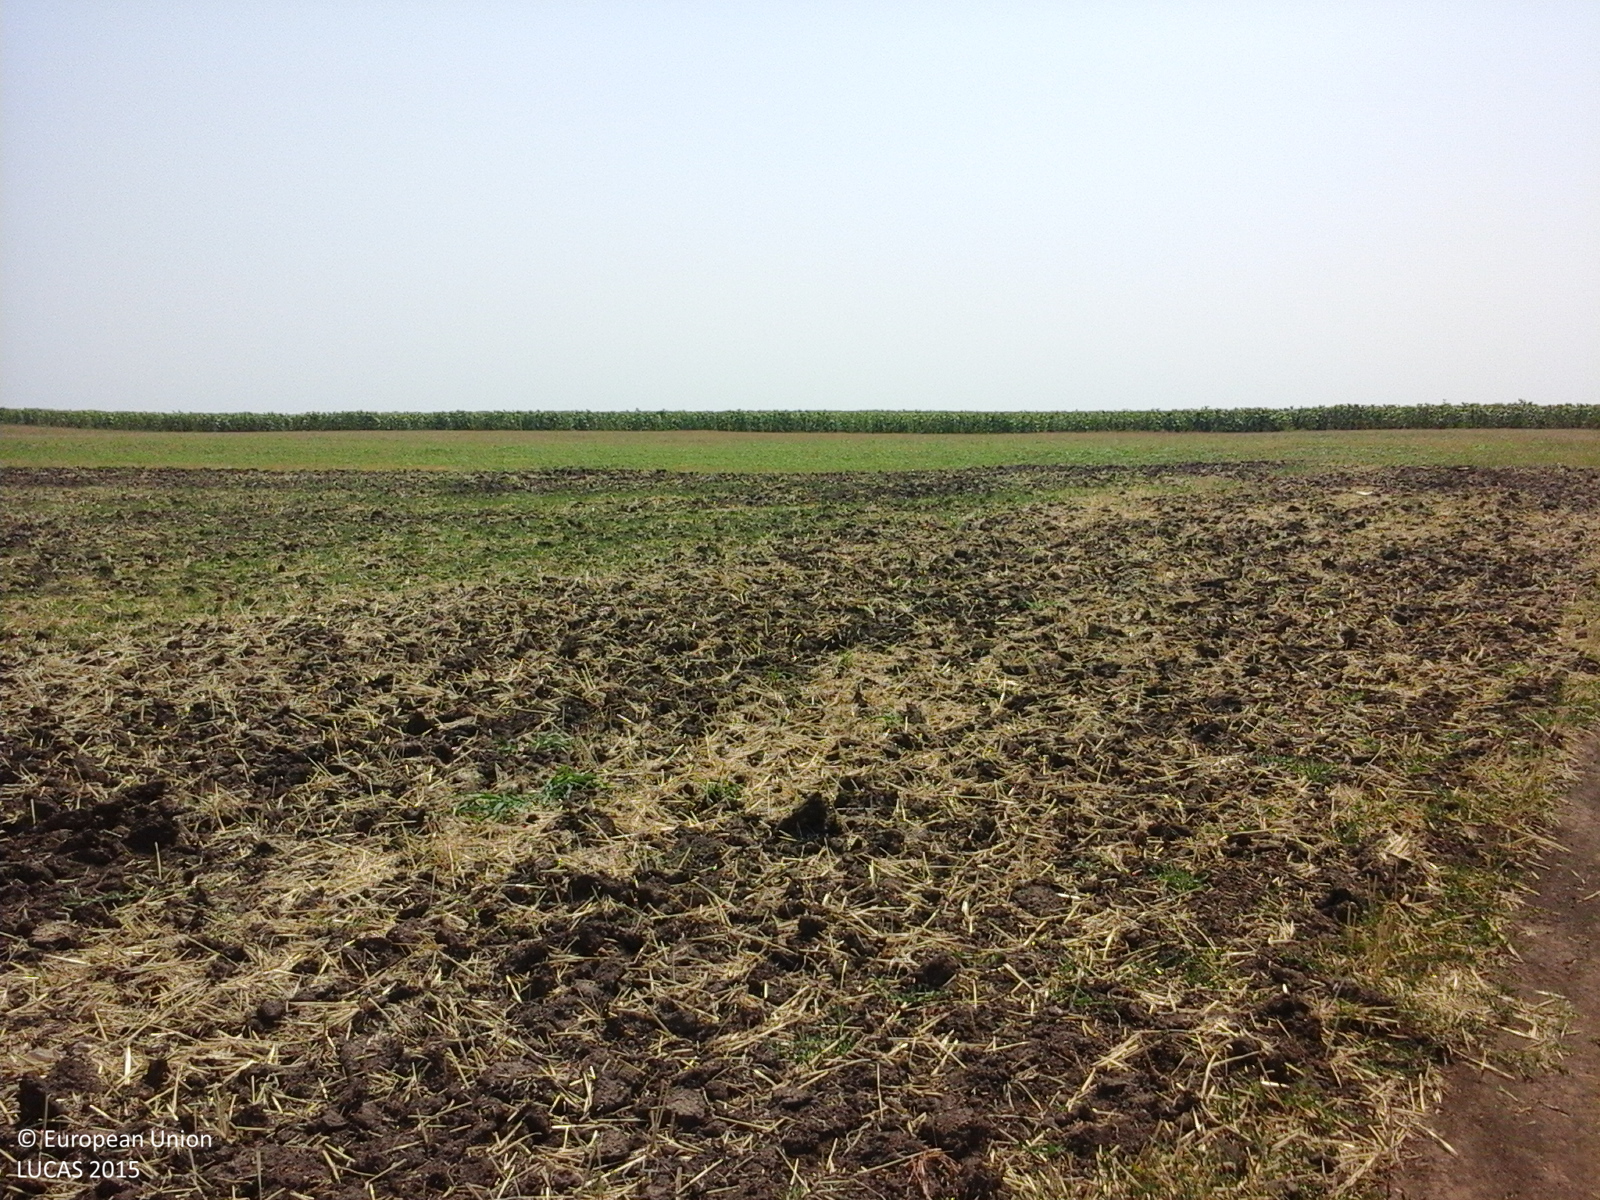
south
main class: Cropland
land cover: Maize
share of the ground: > 75 %
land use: Agriculture (excluding fallow land and kitchen gardens)
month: July
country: RO
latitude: 45.6782
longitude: 27.8705
